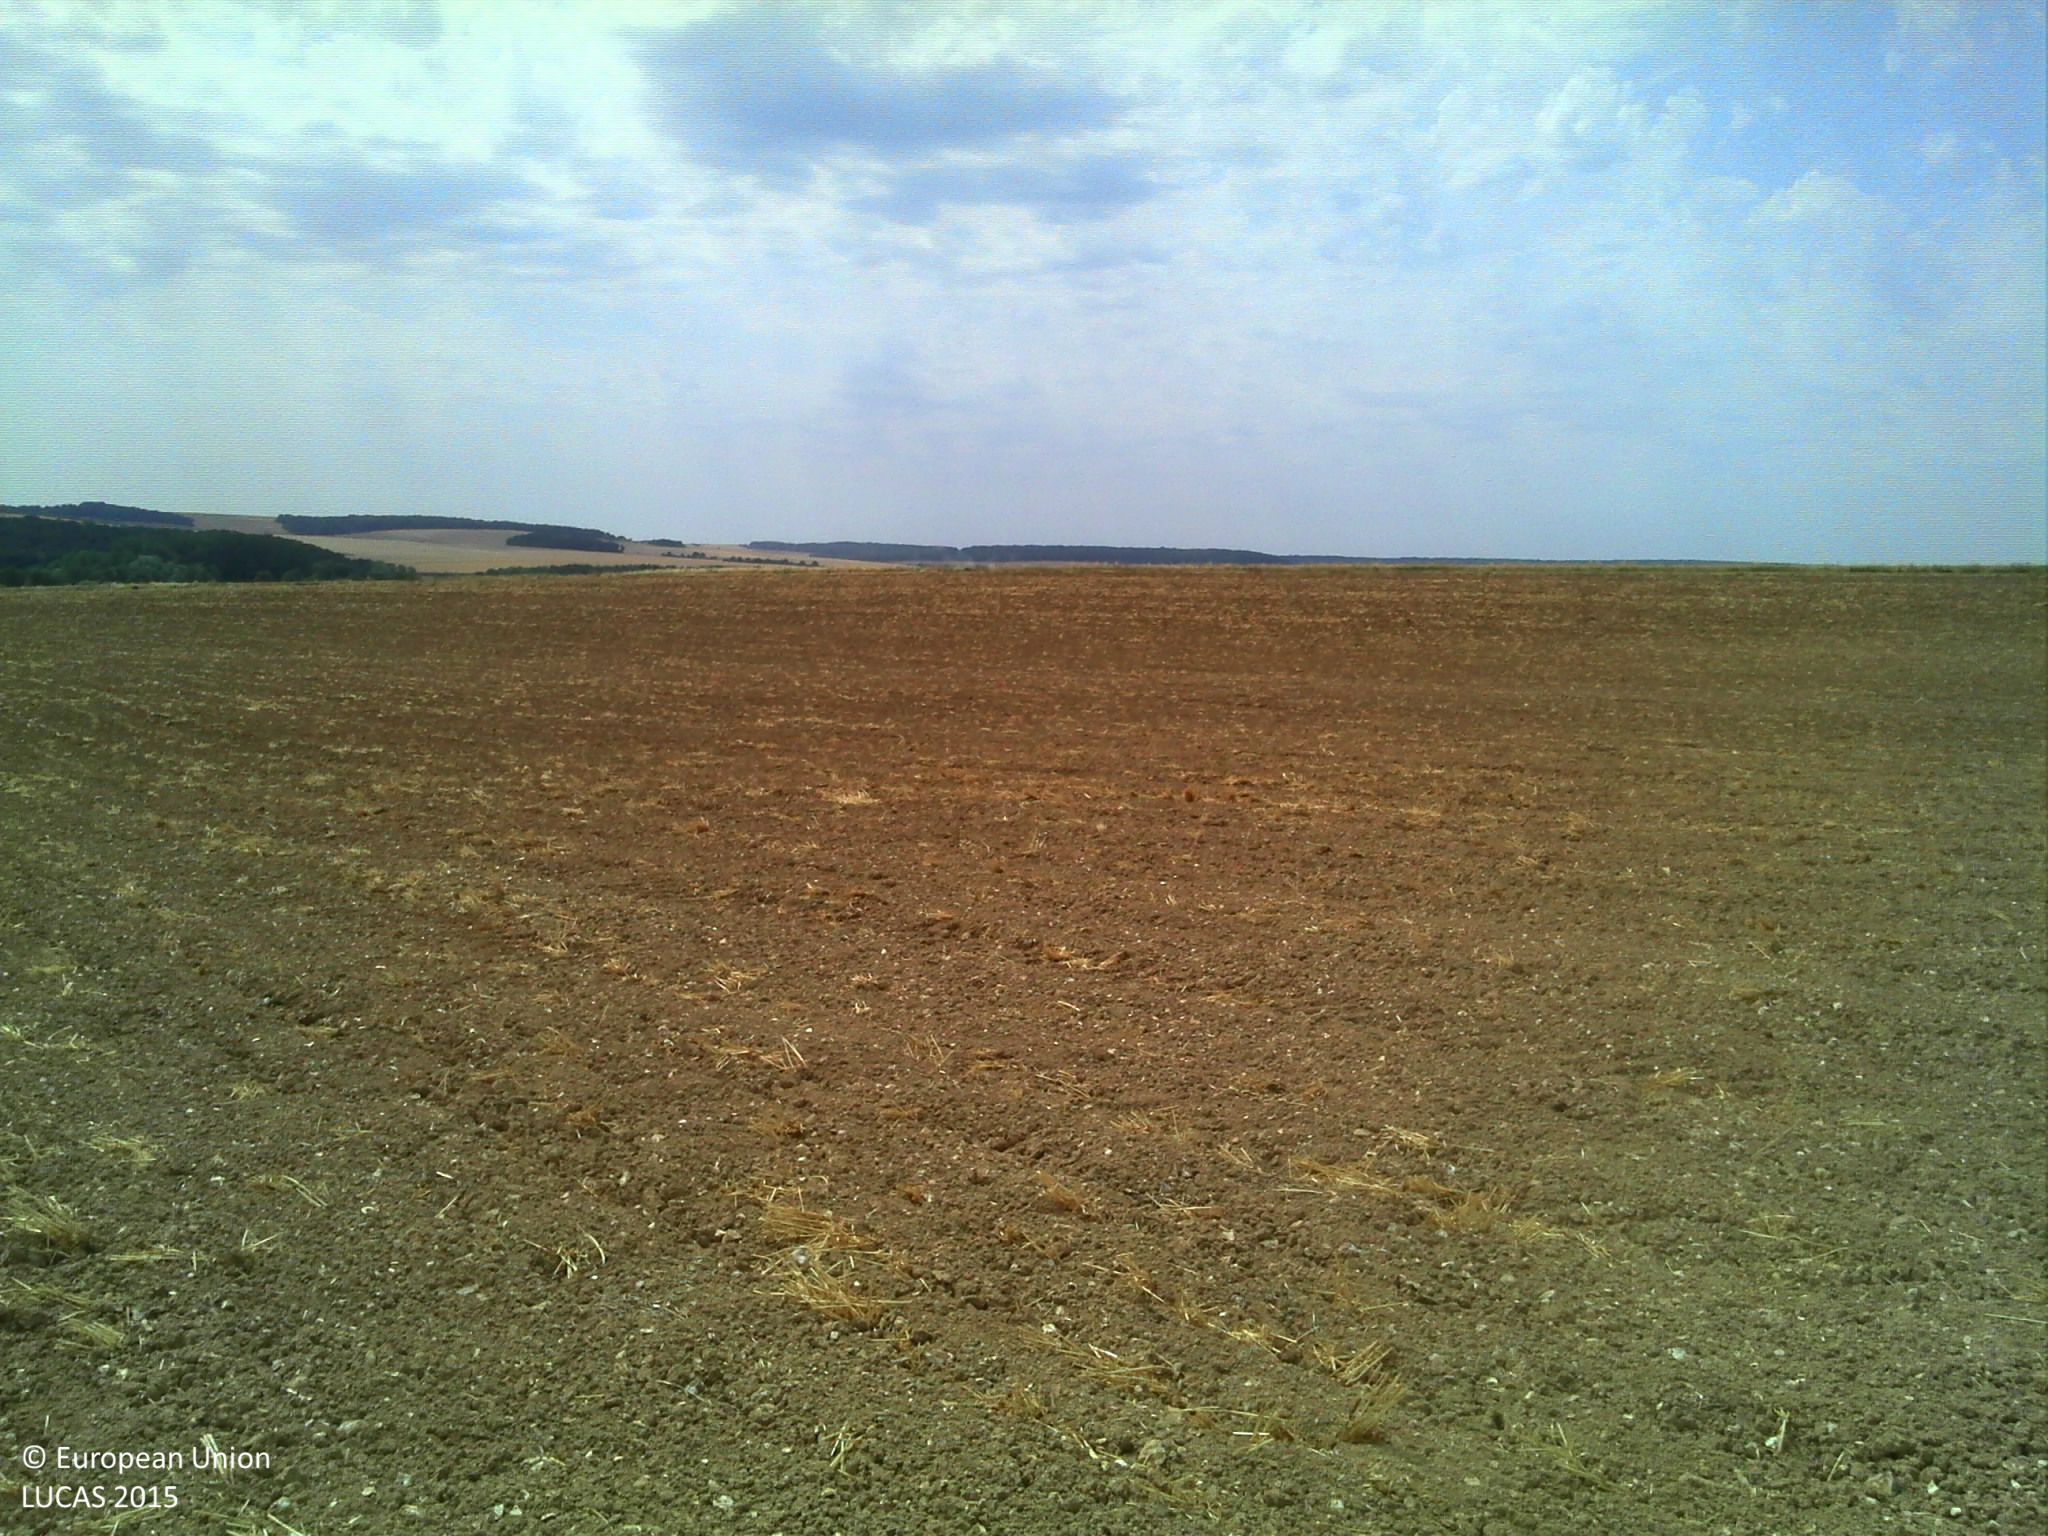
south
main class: Cropland
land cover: Barley
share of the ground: > 75 %
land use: Agriculture (excluding fallow land and kitchen gardens)
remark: Harvested field
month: July
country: FR
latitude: 48.2298
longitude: 3.4921
